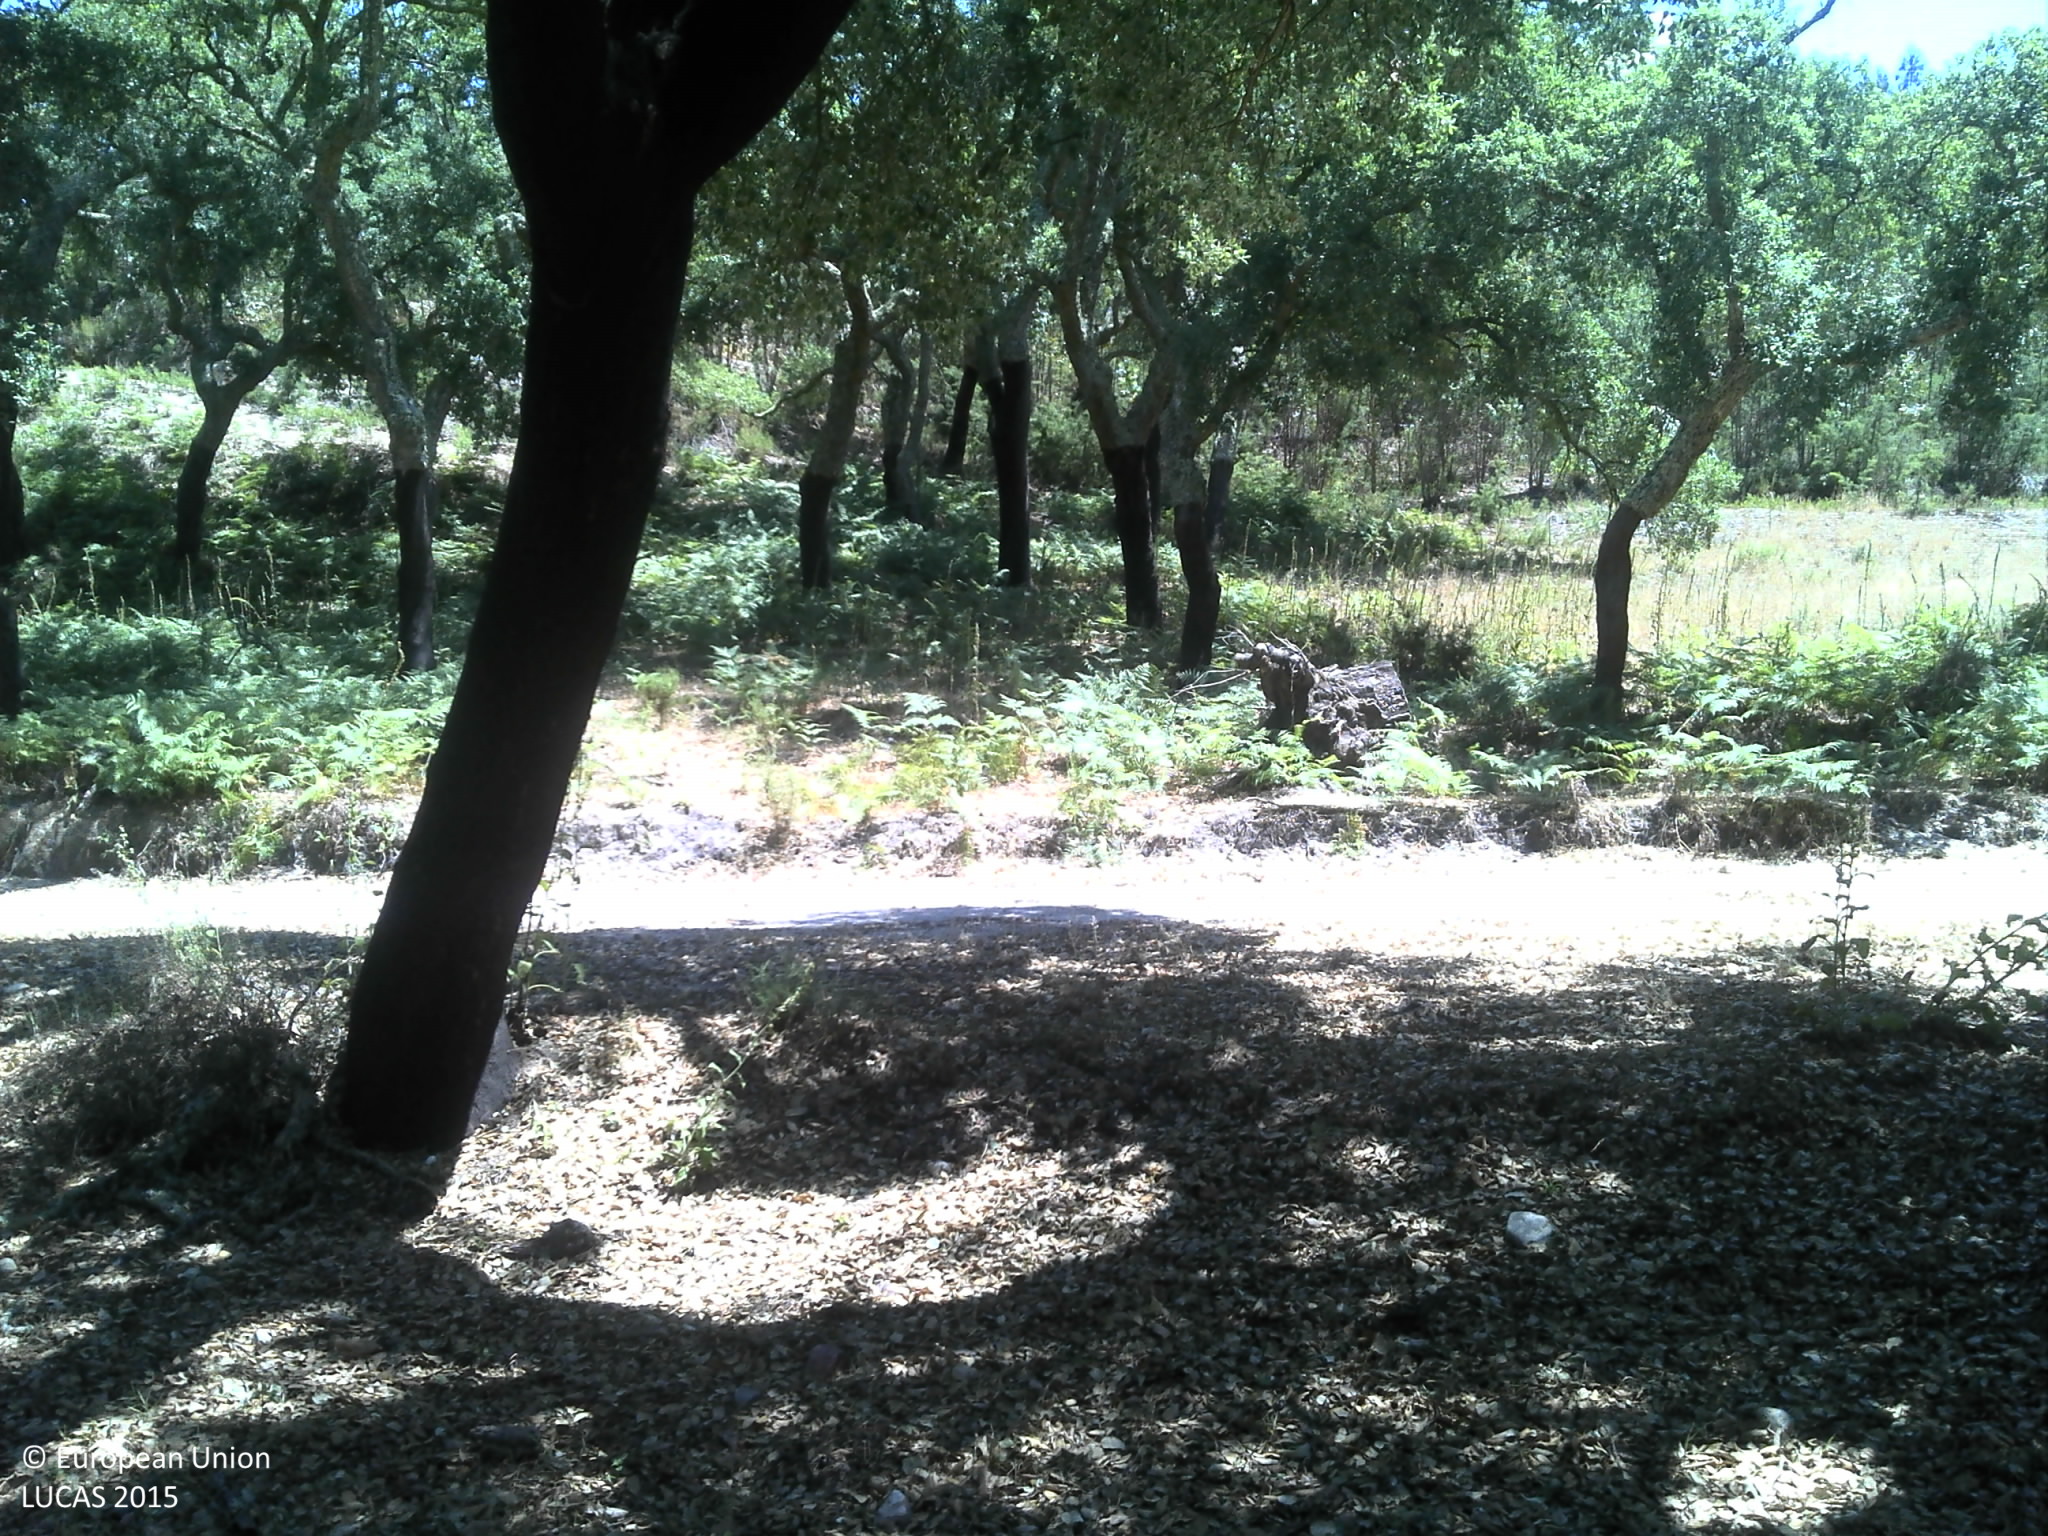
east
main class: Woodland
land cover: Broadleaved woodland
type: broadleaved evergreen forest
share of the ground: 25 - 50 %
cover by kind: broadleaved forest trees 50 %, unconsolidated bare surface 40 %, herbaceous plants 10 %
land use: Forestry
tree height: > 5 m
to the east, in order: Broadleaved woodland; Grassland without tree/shrub cover; Tracks; Broadleaved woodland; Tracks; Broadleaved woodland; Tracks; Broadleaved woodland
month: June
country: PT
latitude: 39.3096
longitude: -8.2826
